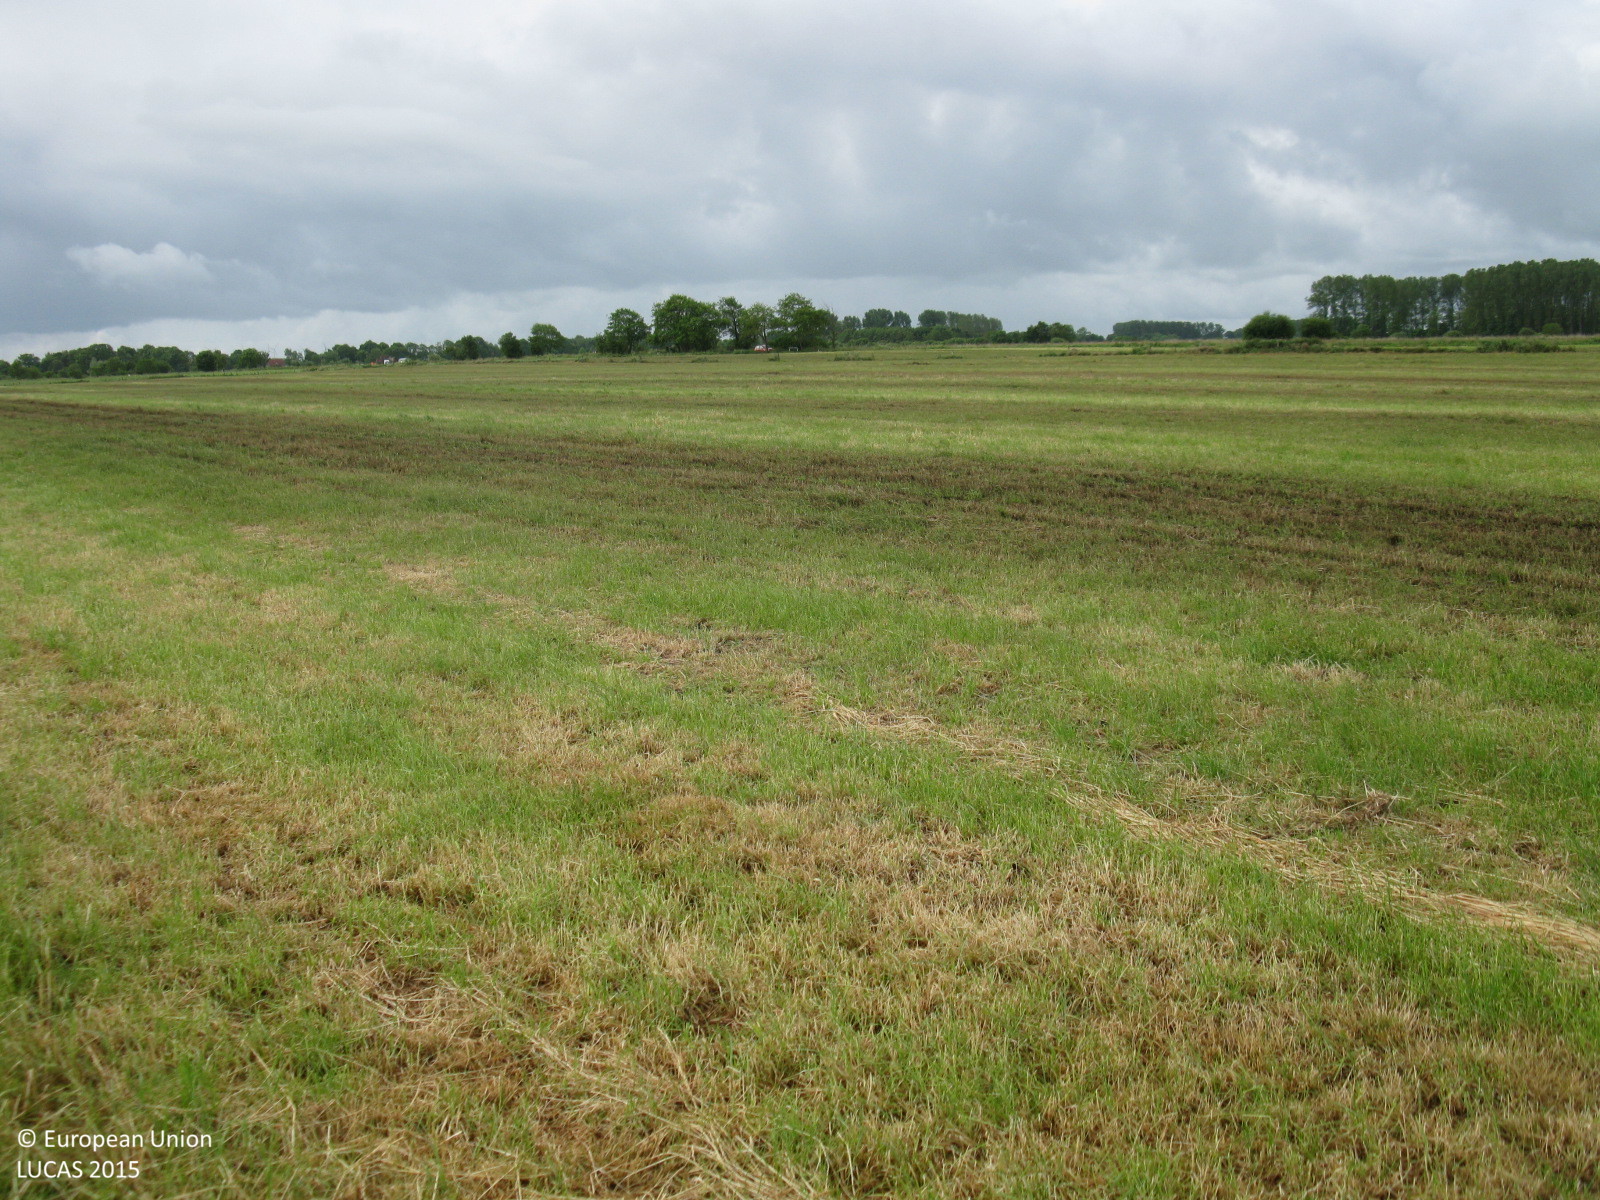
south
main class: Grassland
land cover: Grassland without tree/shrub cover
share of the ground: > 75 %
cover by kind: herbaceous plants 100 %
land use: Agriculture (excluding fallow land and kitchen gardens)
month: June
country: DE
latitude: 53.4626
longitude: 7.3346
